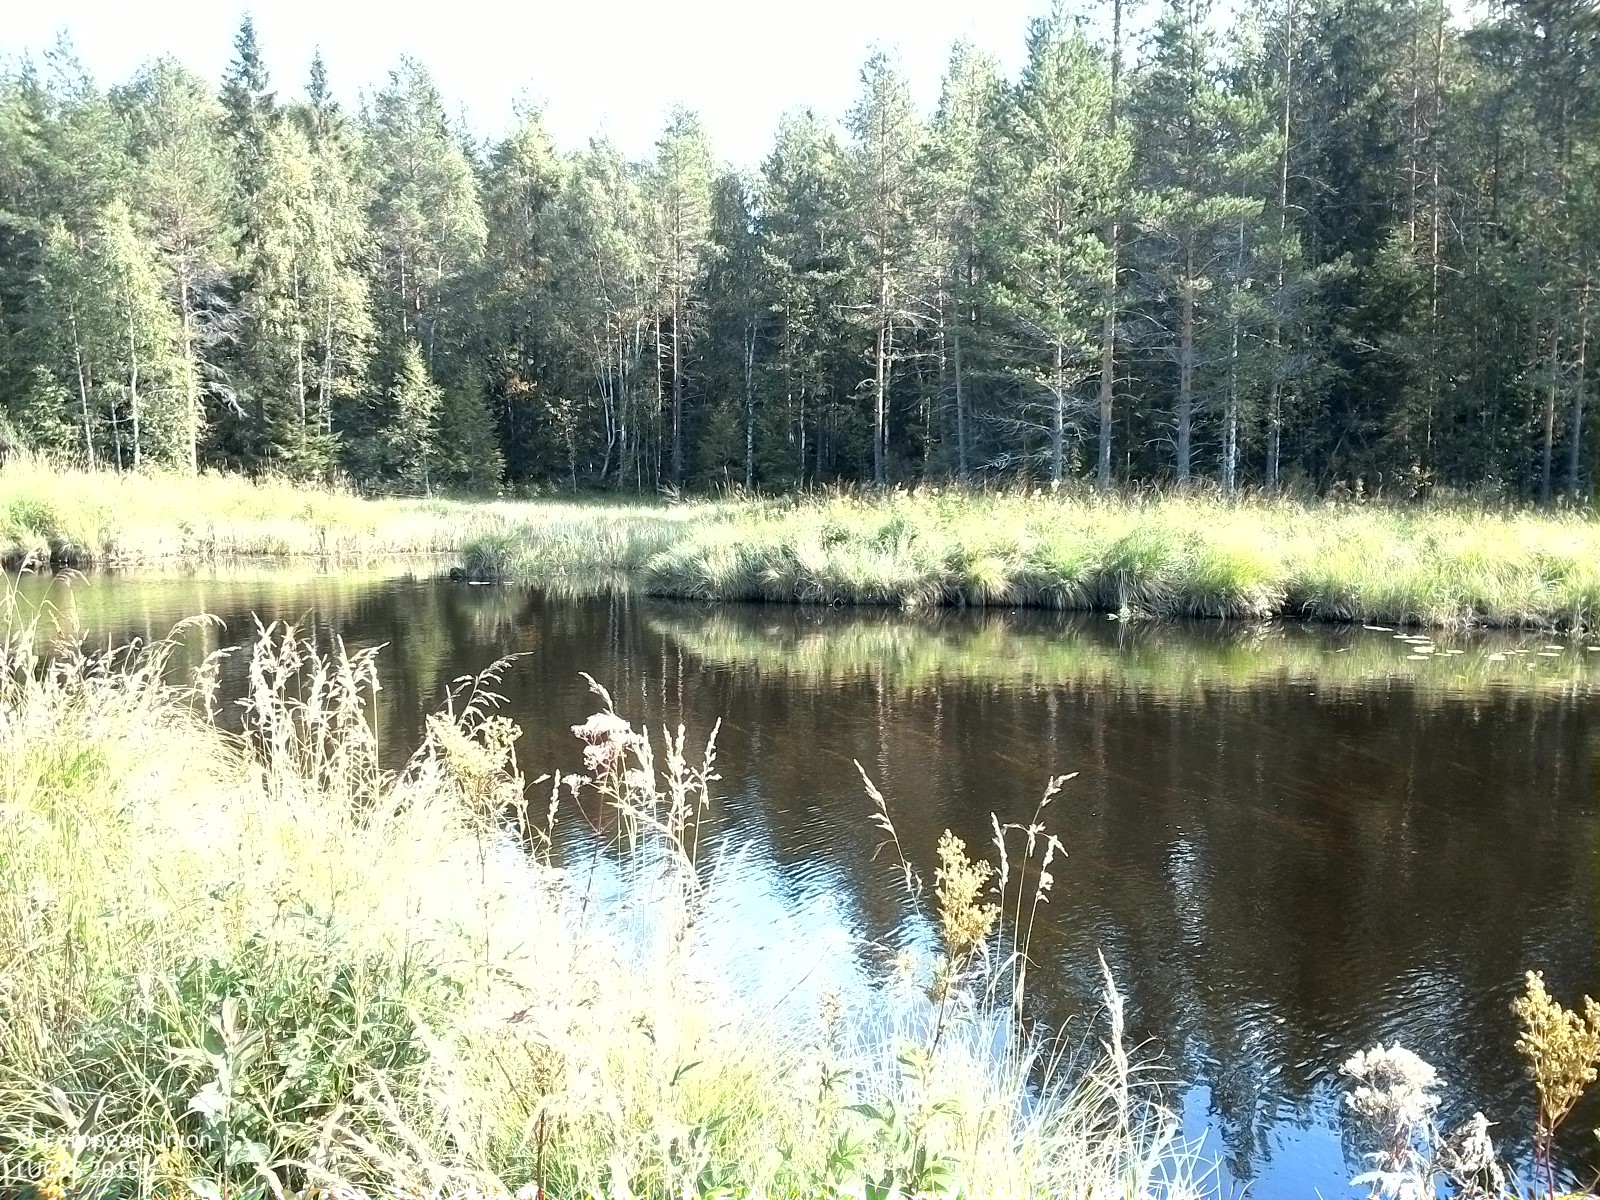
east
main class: Grassland
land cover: Grassland without tree/shrub cover
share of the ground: > 75 %
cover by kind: herbaceous plants 100 %
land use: Semi-natural and natural areas not in use
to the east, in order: Grassland without tree/shrub cover; Inland fresh running water; Grassland without tree/shrub cover; Other mixed woodland; Tracks; Other mixed woodland; Other coniferous woodland; Ditches and canals; Other coniferous woodland
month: August
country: SE
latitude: 62.4485
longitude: 16.2002
